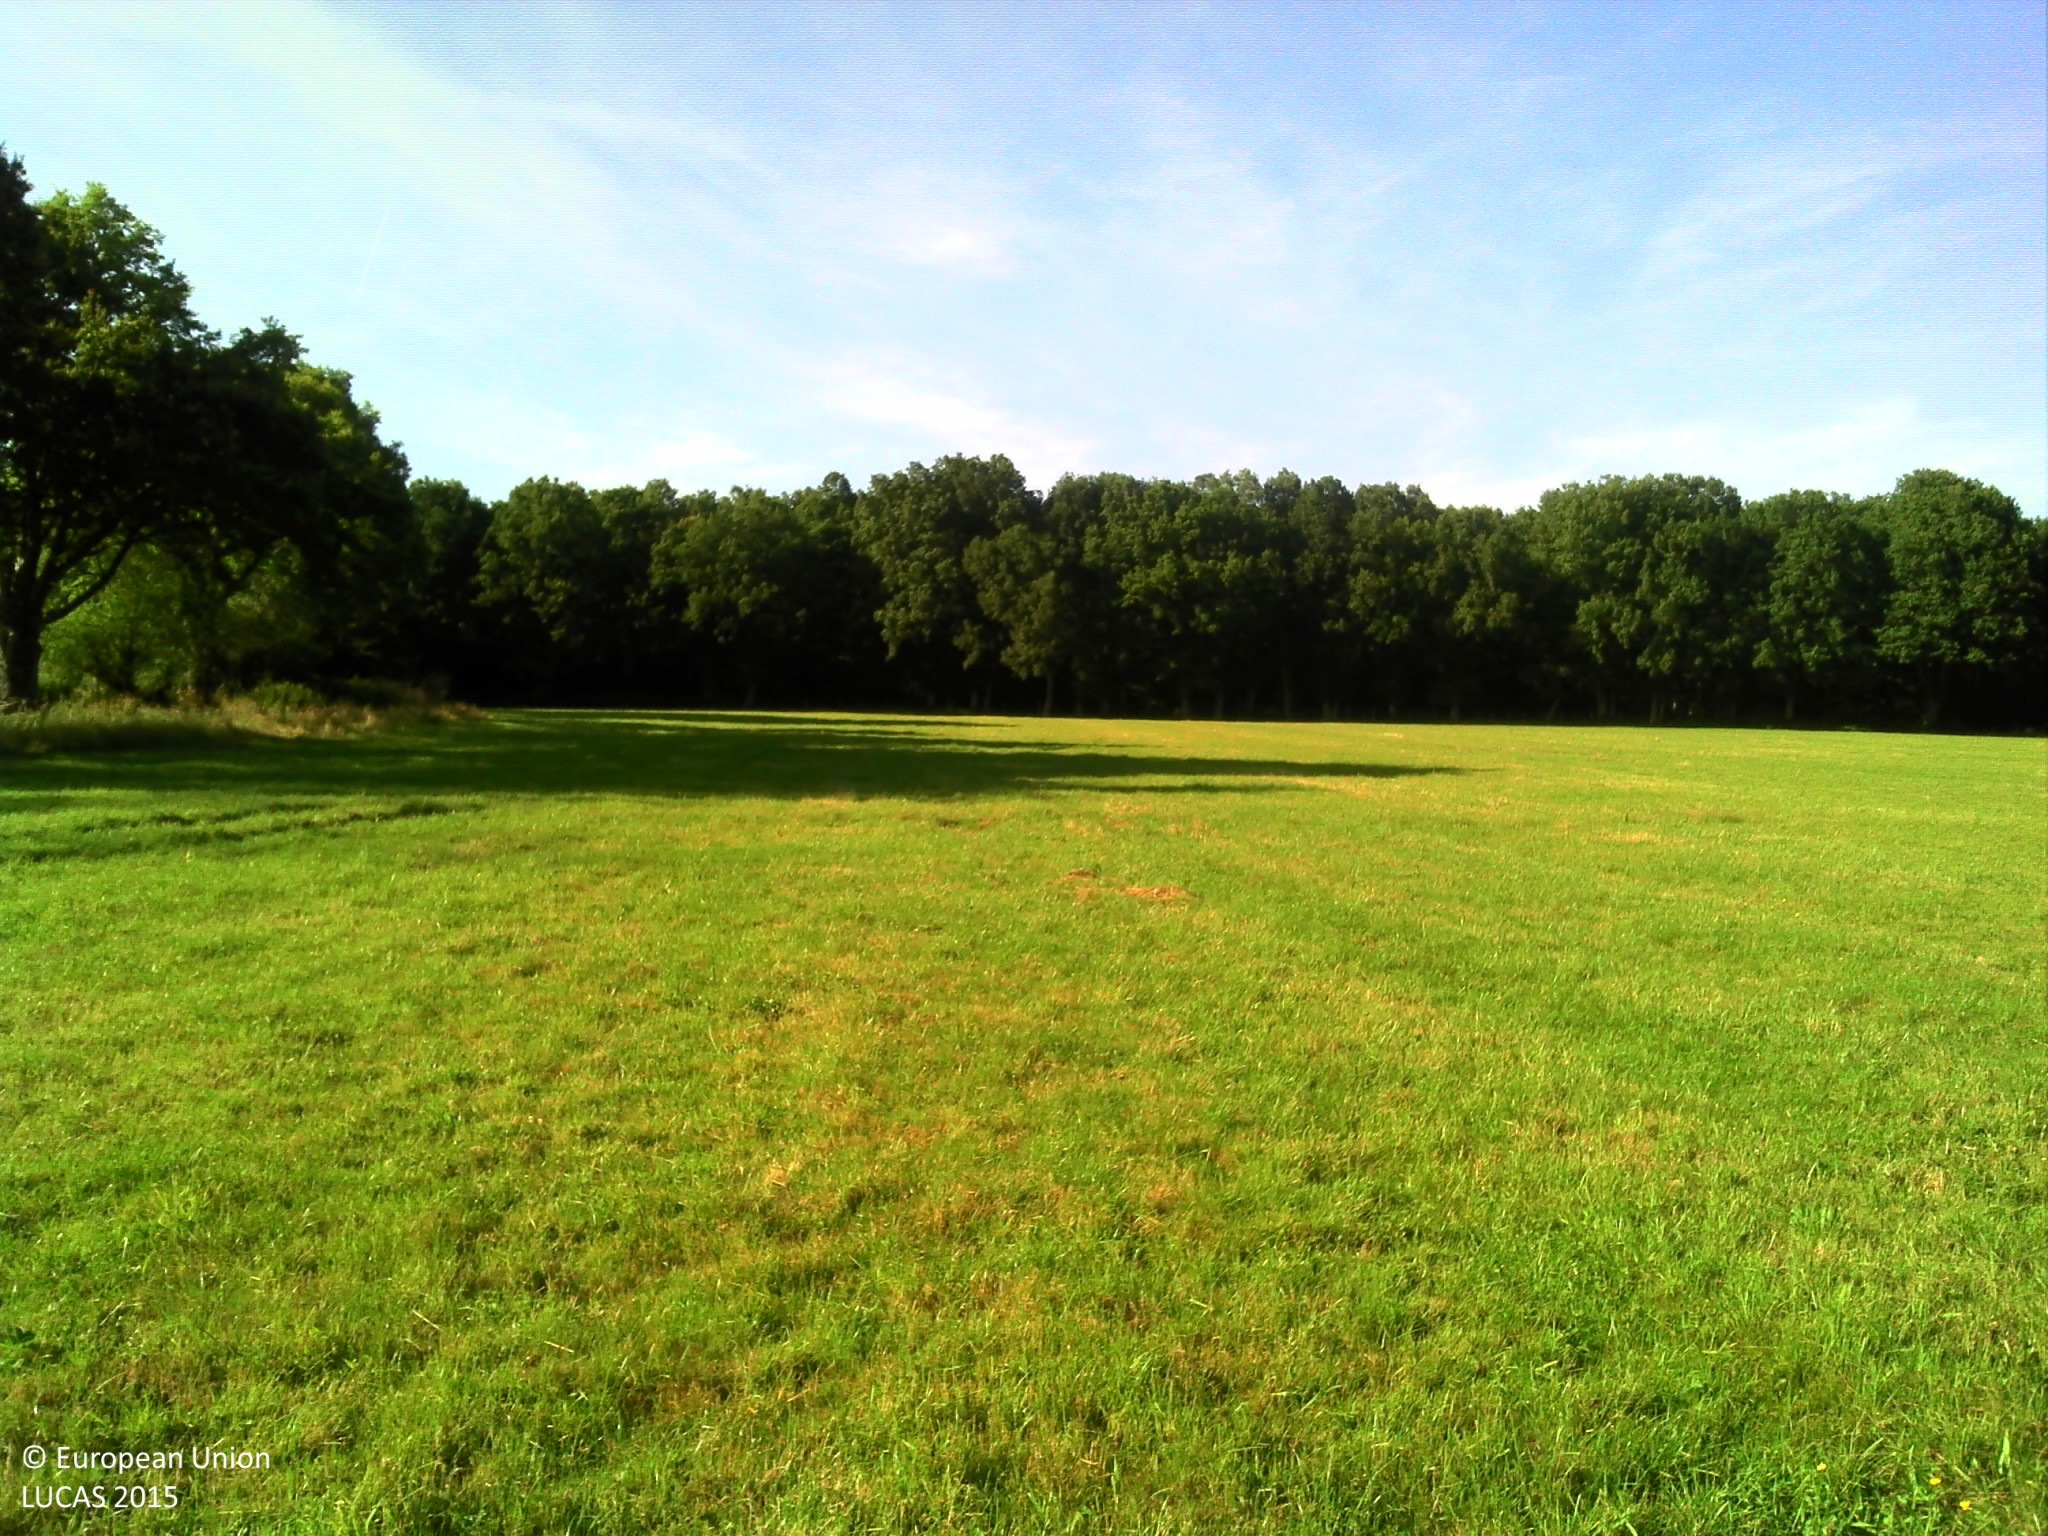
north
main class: Grassland
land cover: Grassland without tree/shrub cover
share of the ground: > 75 %
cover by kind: herbaceous plants 100 %
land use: Agriculture (excluding fallow land and kitchen gardens)
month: June
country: FR
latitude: 46.8238
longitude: 2.9569
